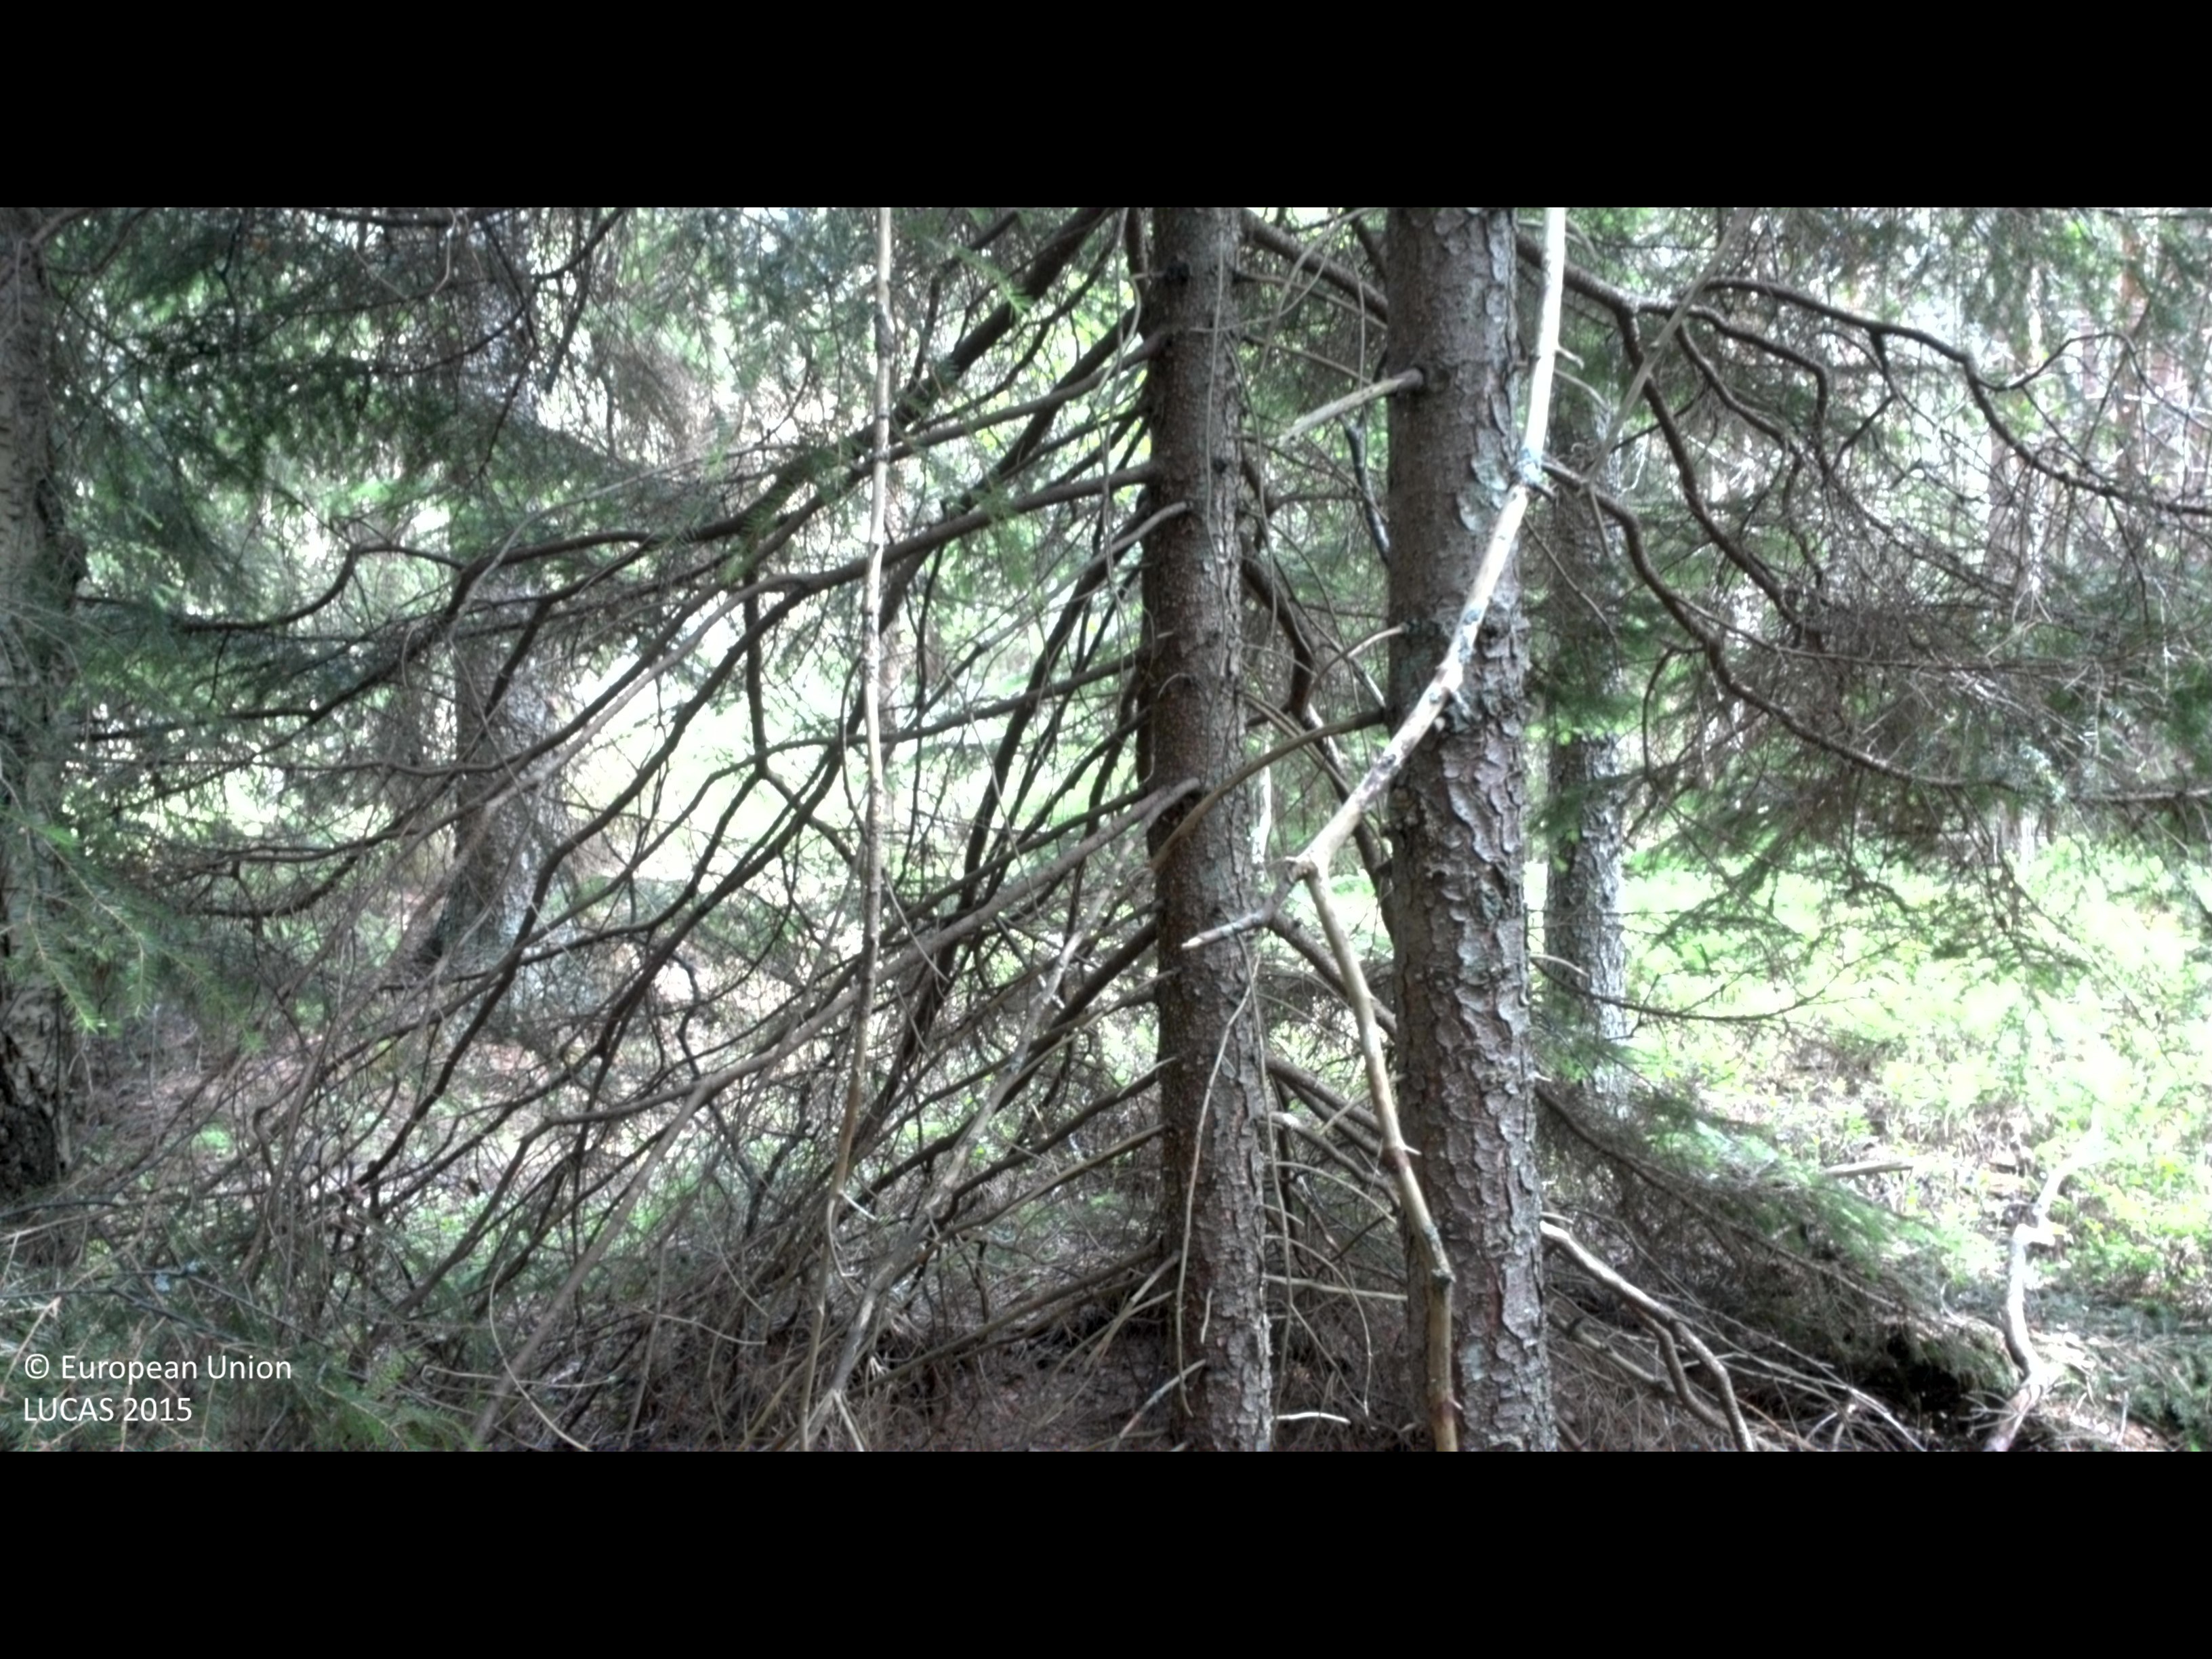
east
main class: Woodland
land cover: Spruce dominated coniferous woodland
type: boreal forest
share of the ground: > 75 %
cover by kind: coniferous forest trees 70 %, broadleaved forest trees 20 %, shrubs 10 %
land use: Forestry
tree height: > 5 m
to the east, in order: Spruce dominated coniferous woodland; Spruce dominated mixed woodland; Pine dominated coniferous woodland
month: June
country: SE
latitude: 57.9488
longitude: 16.6042
